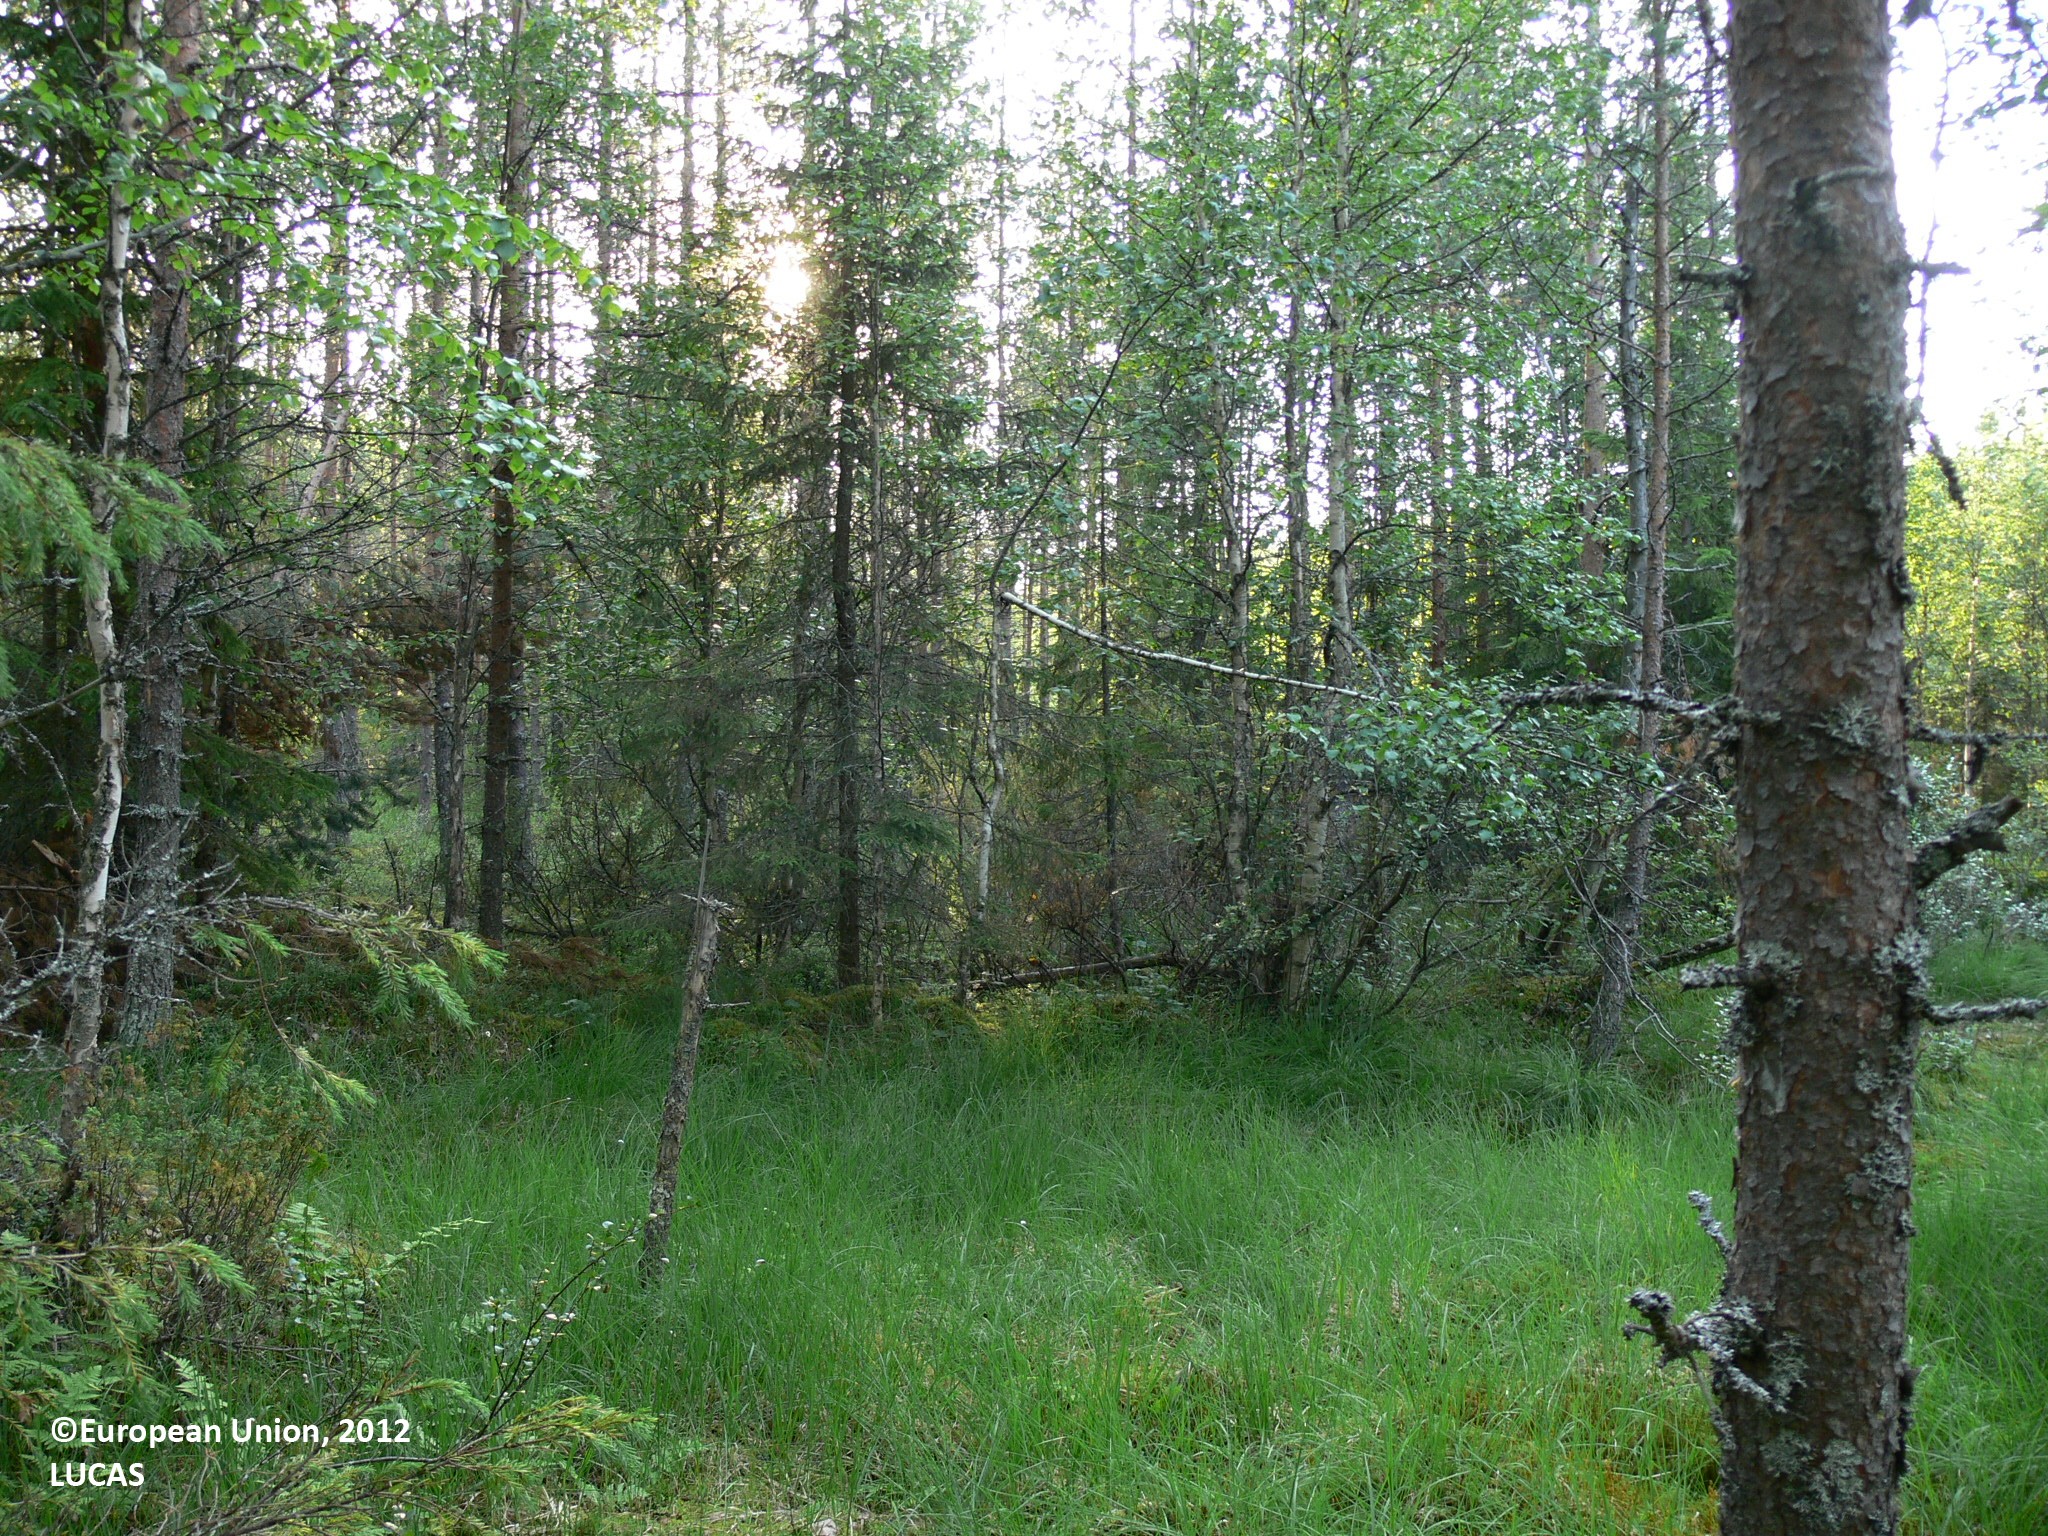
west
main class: Woodland
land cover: Pine dominated mixed woodland
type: boreal forest
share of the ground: > 75 %
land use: Forestry
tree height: > 5 m
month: July
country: FI
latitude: 63.3262
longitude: 30.8331
